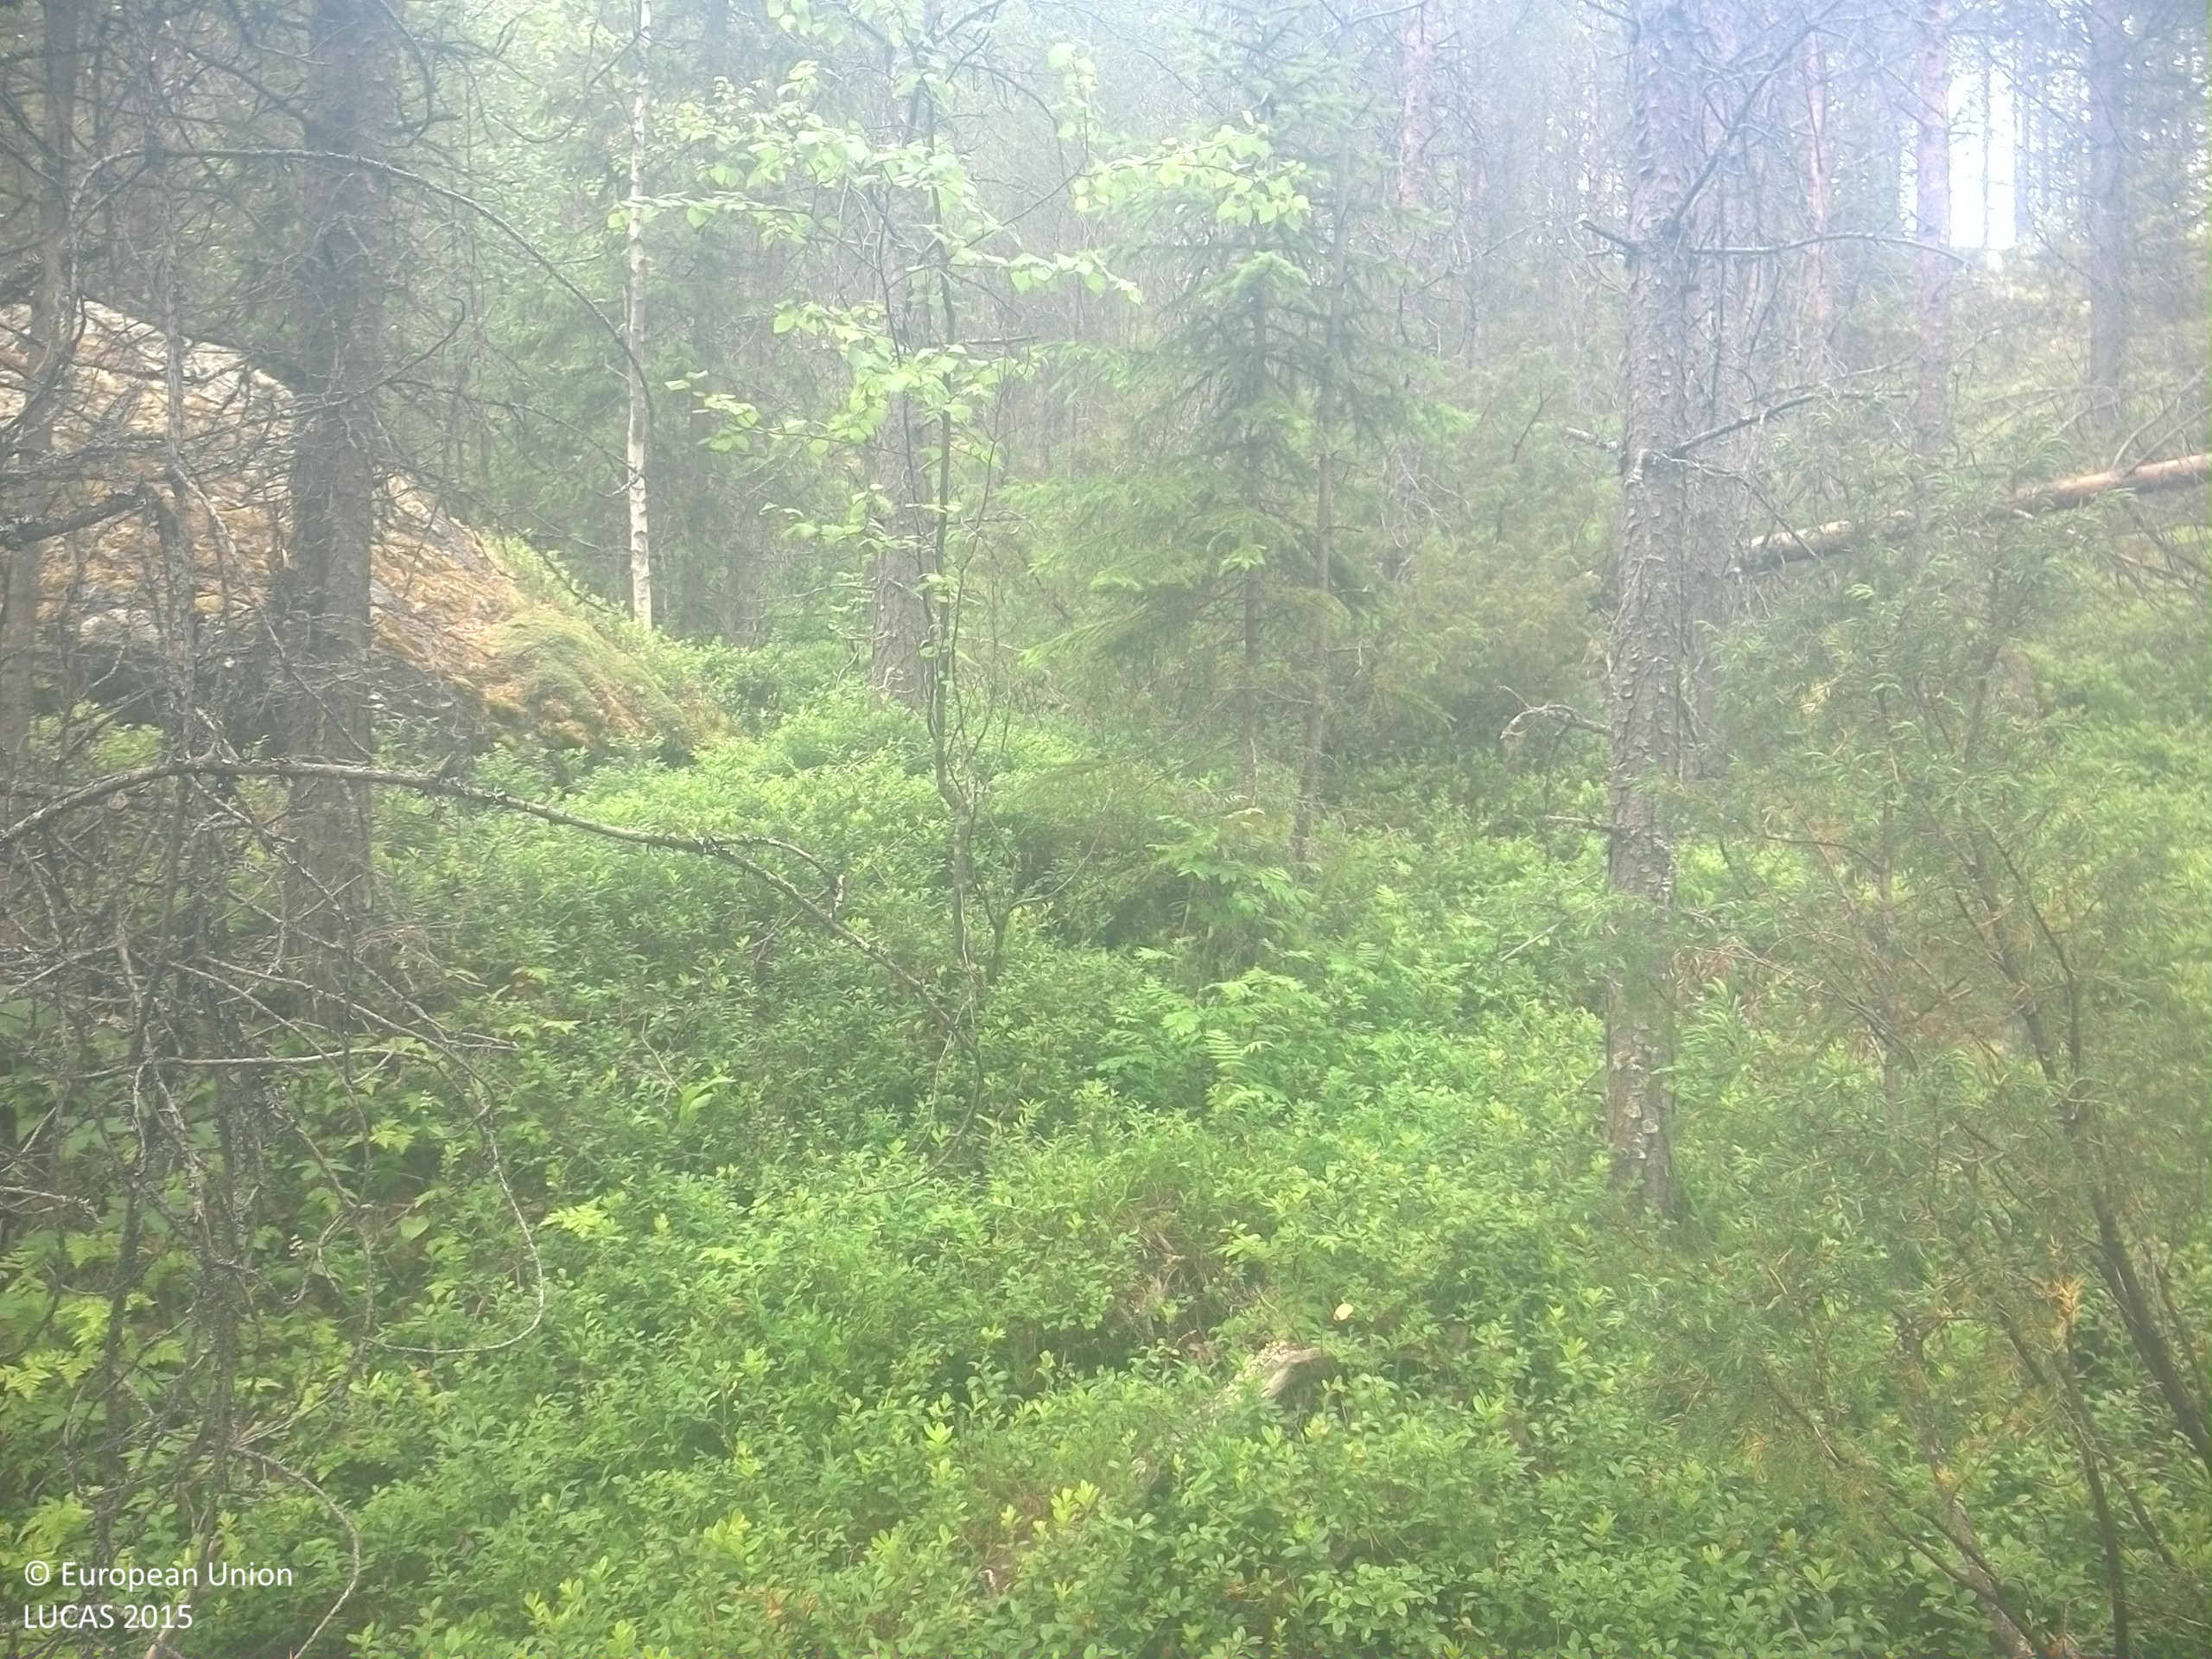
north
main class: Woodland
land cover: Pine dominated coniferous woodland
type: boreal forest
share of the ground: 50 - 75 %
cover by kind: coniferous forest trees 50 %, shrubs 30 %, lichens and mosses 10 %, broadleaved forest trees 5 %, consolidated bare surface 5 %
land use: Forestry
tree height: > 5 m
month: July
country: SE
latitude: 64.1824
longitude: 16.7404
